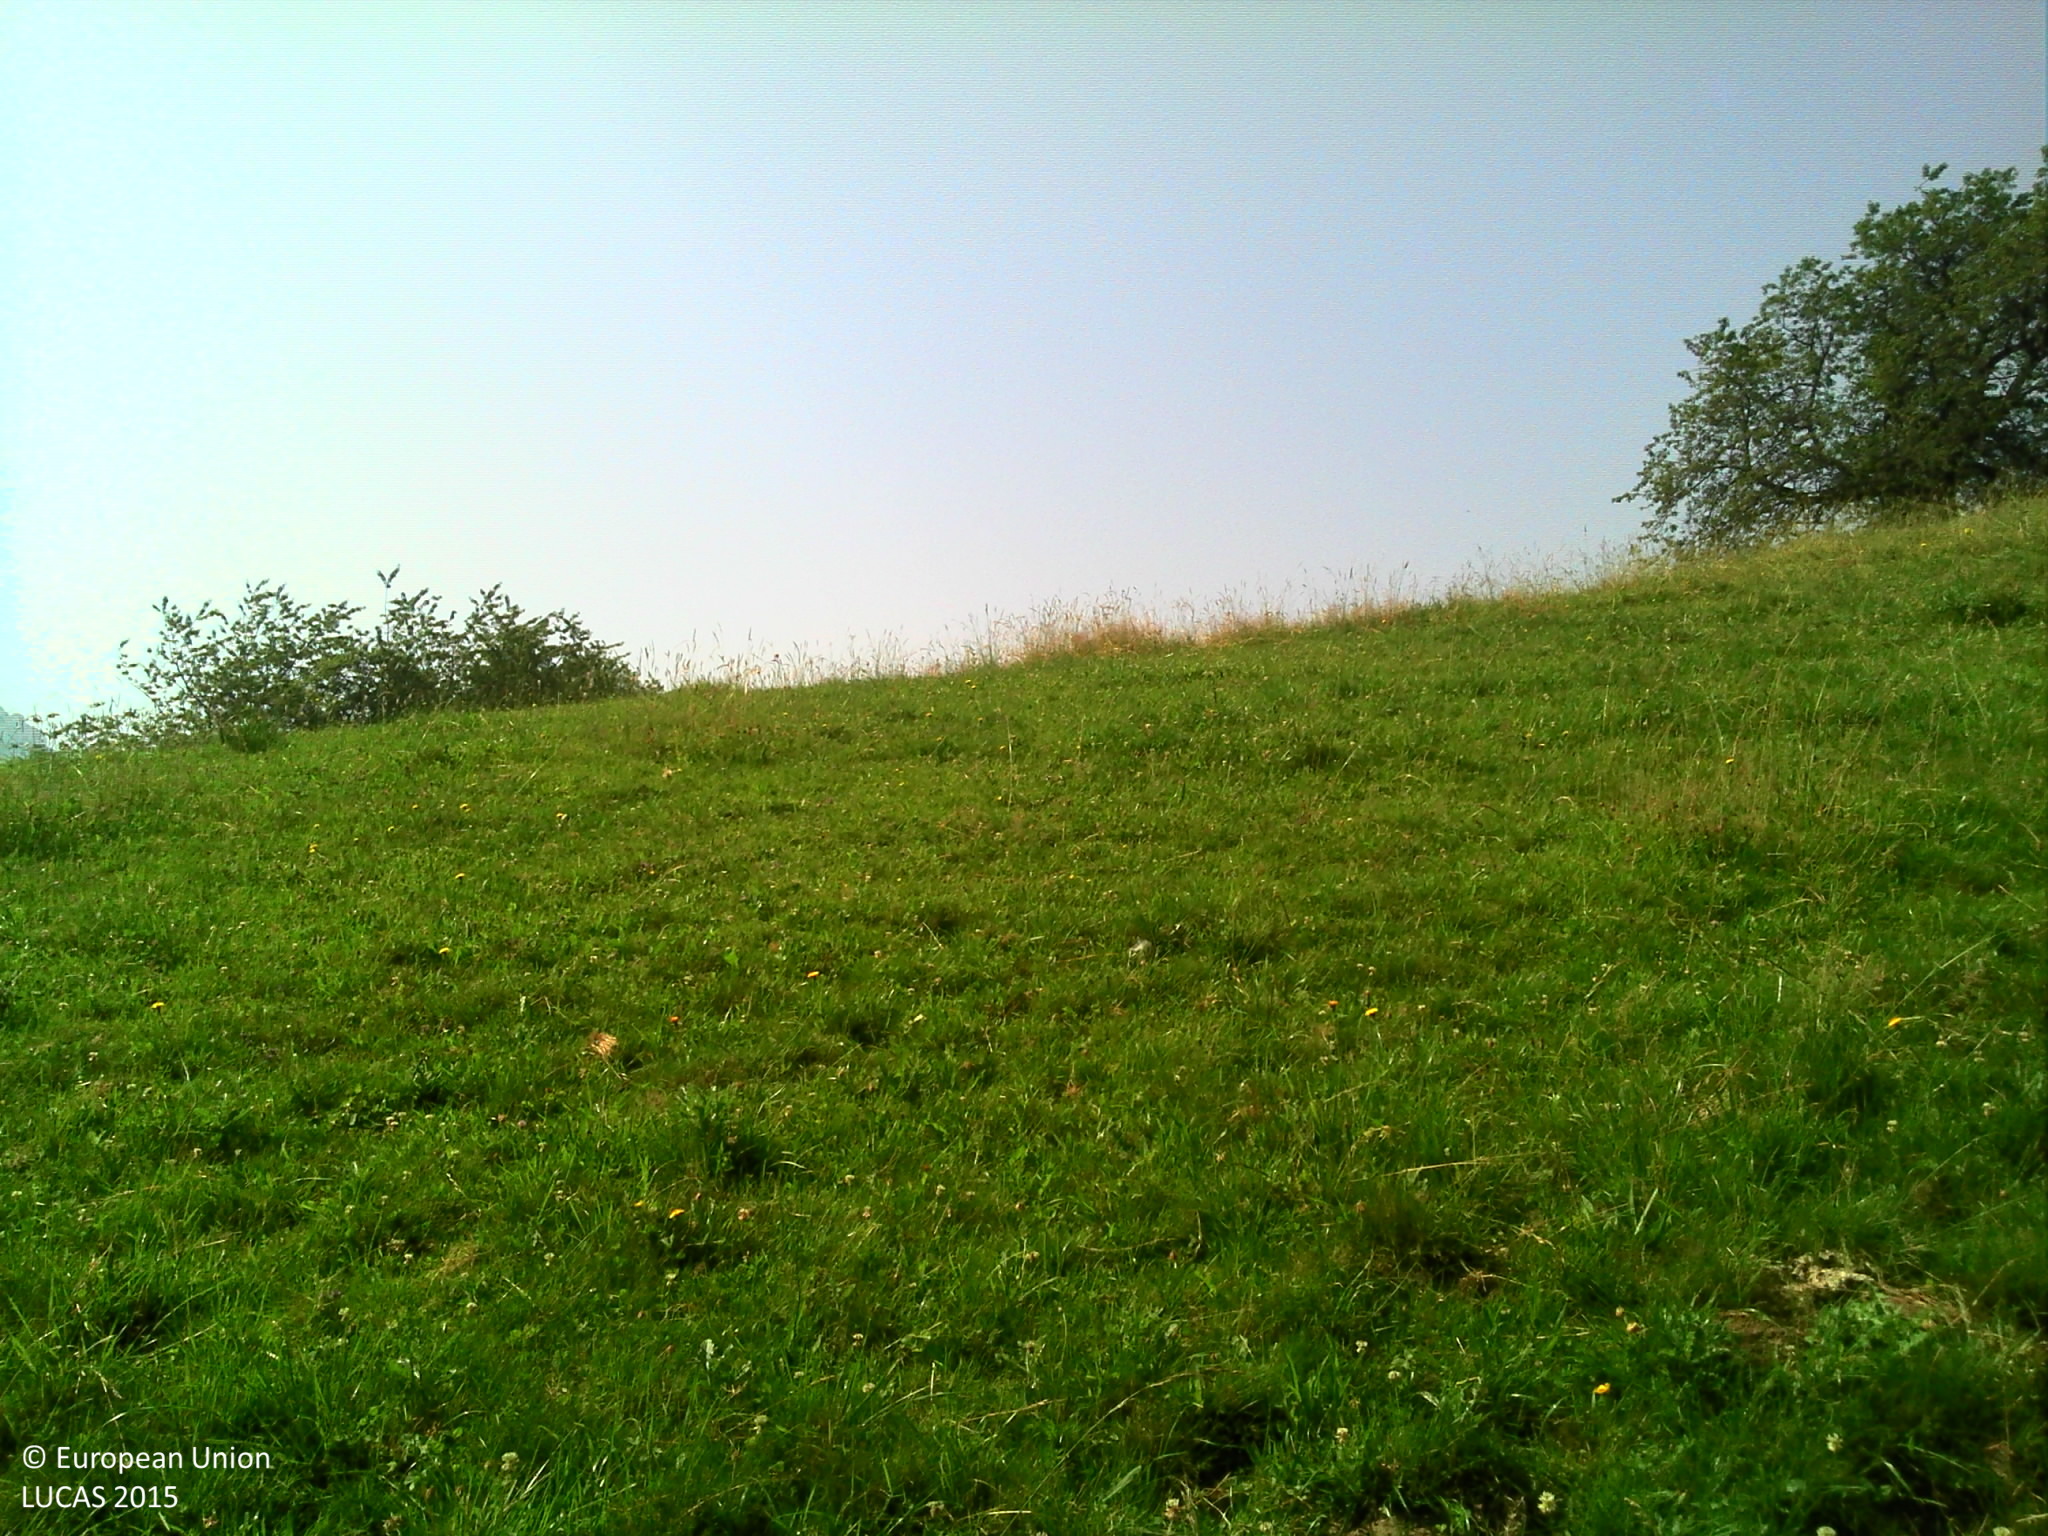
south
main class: Grassland
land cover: Grassland without tree/shrub cover
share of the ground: > 75 %
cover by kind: herbaceous plants 100 %
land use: Agriculture (excluding fallow land and kitchen gardens)
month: July
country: FR
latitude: 45.7944
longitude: 6.1318
